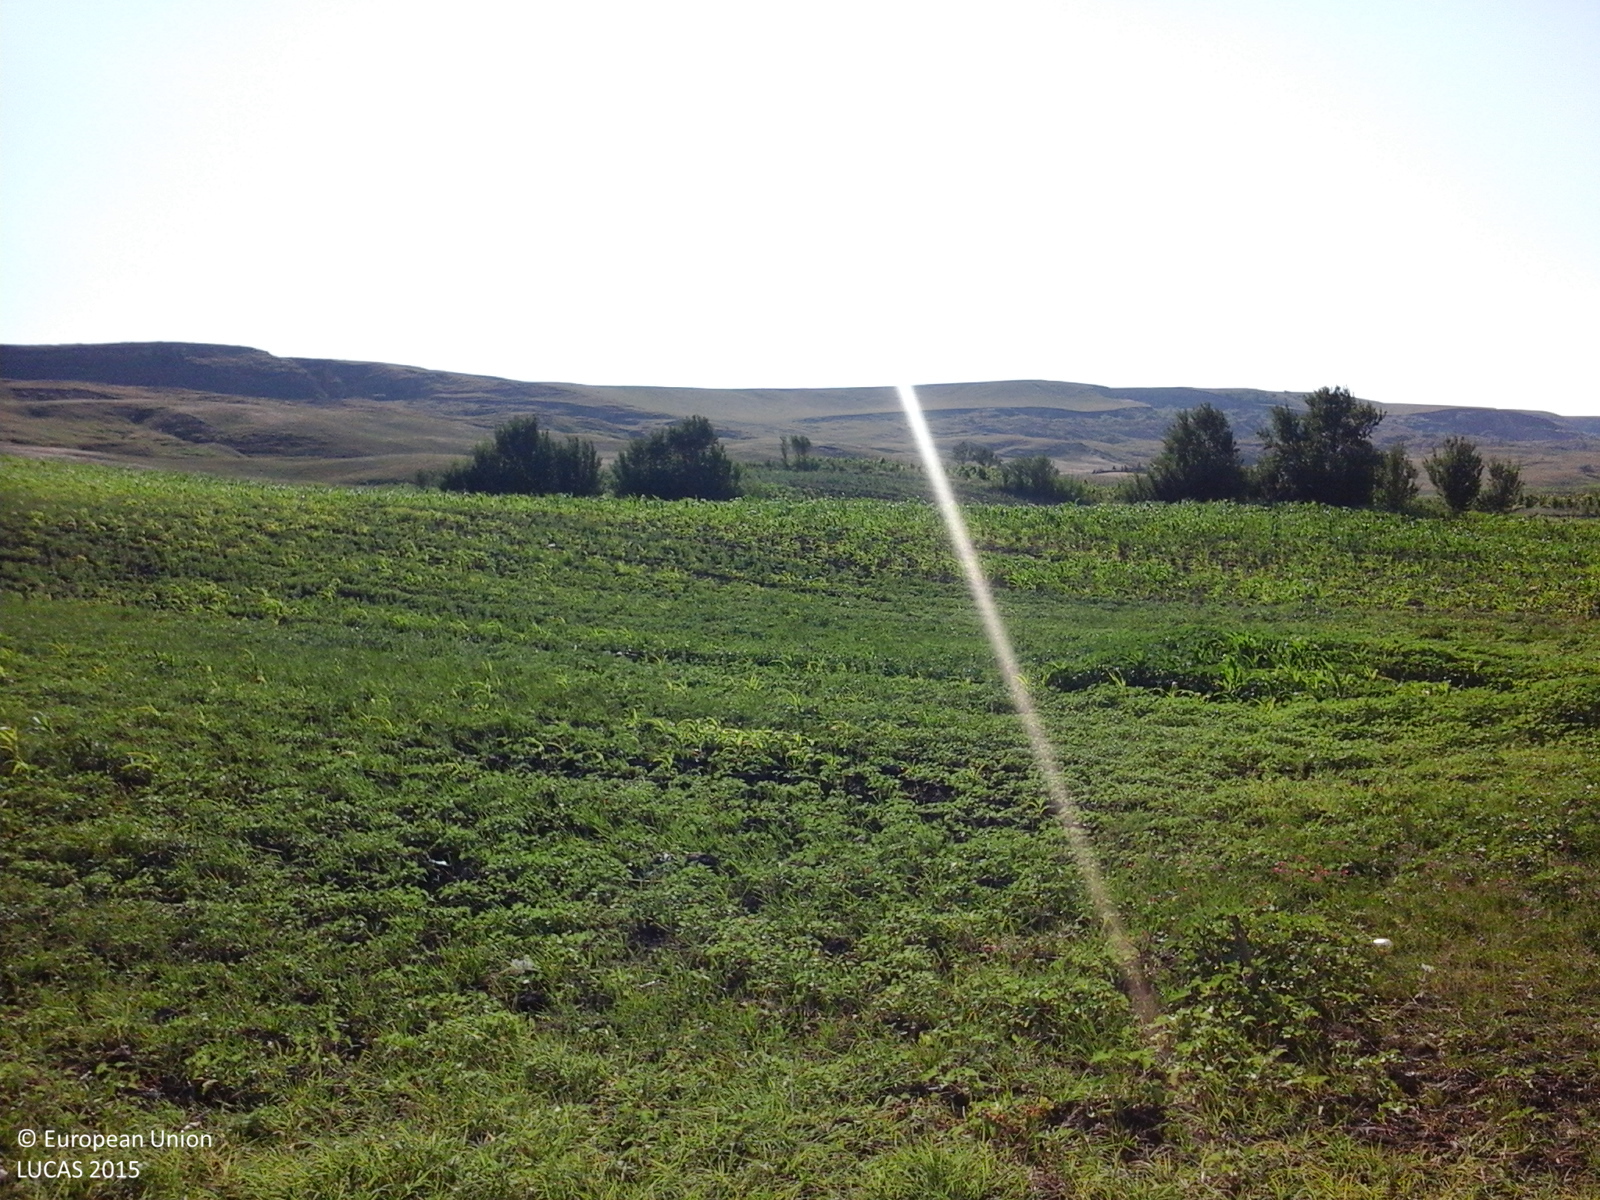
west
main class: Grassland
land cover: Grassland without tree/shrub cover
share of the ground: > 75 %
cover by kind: herbaceous plants 100 %
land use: Agriculture (excluding fallow land and kitchen gardens)
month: June
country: RO
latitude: 46.8225
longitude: 27.7511
